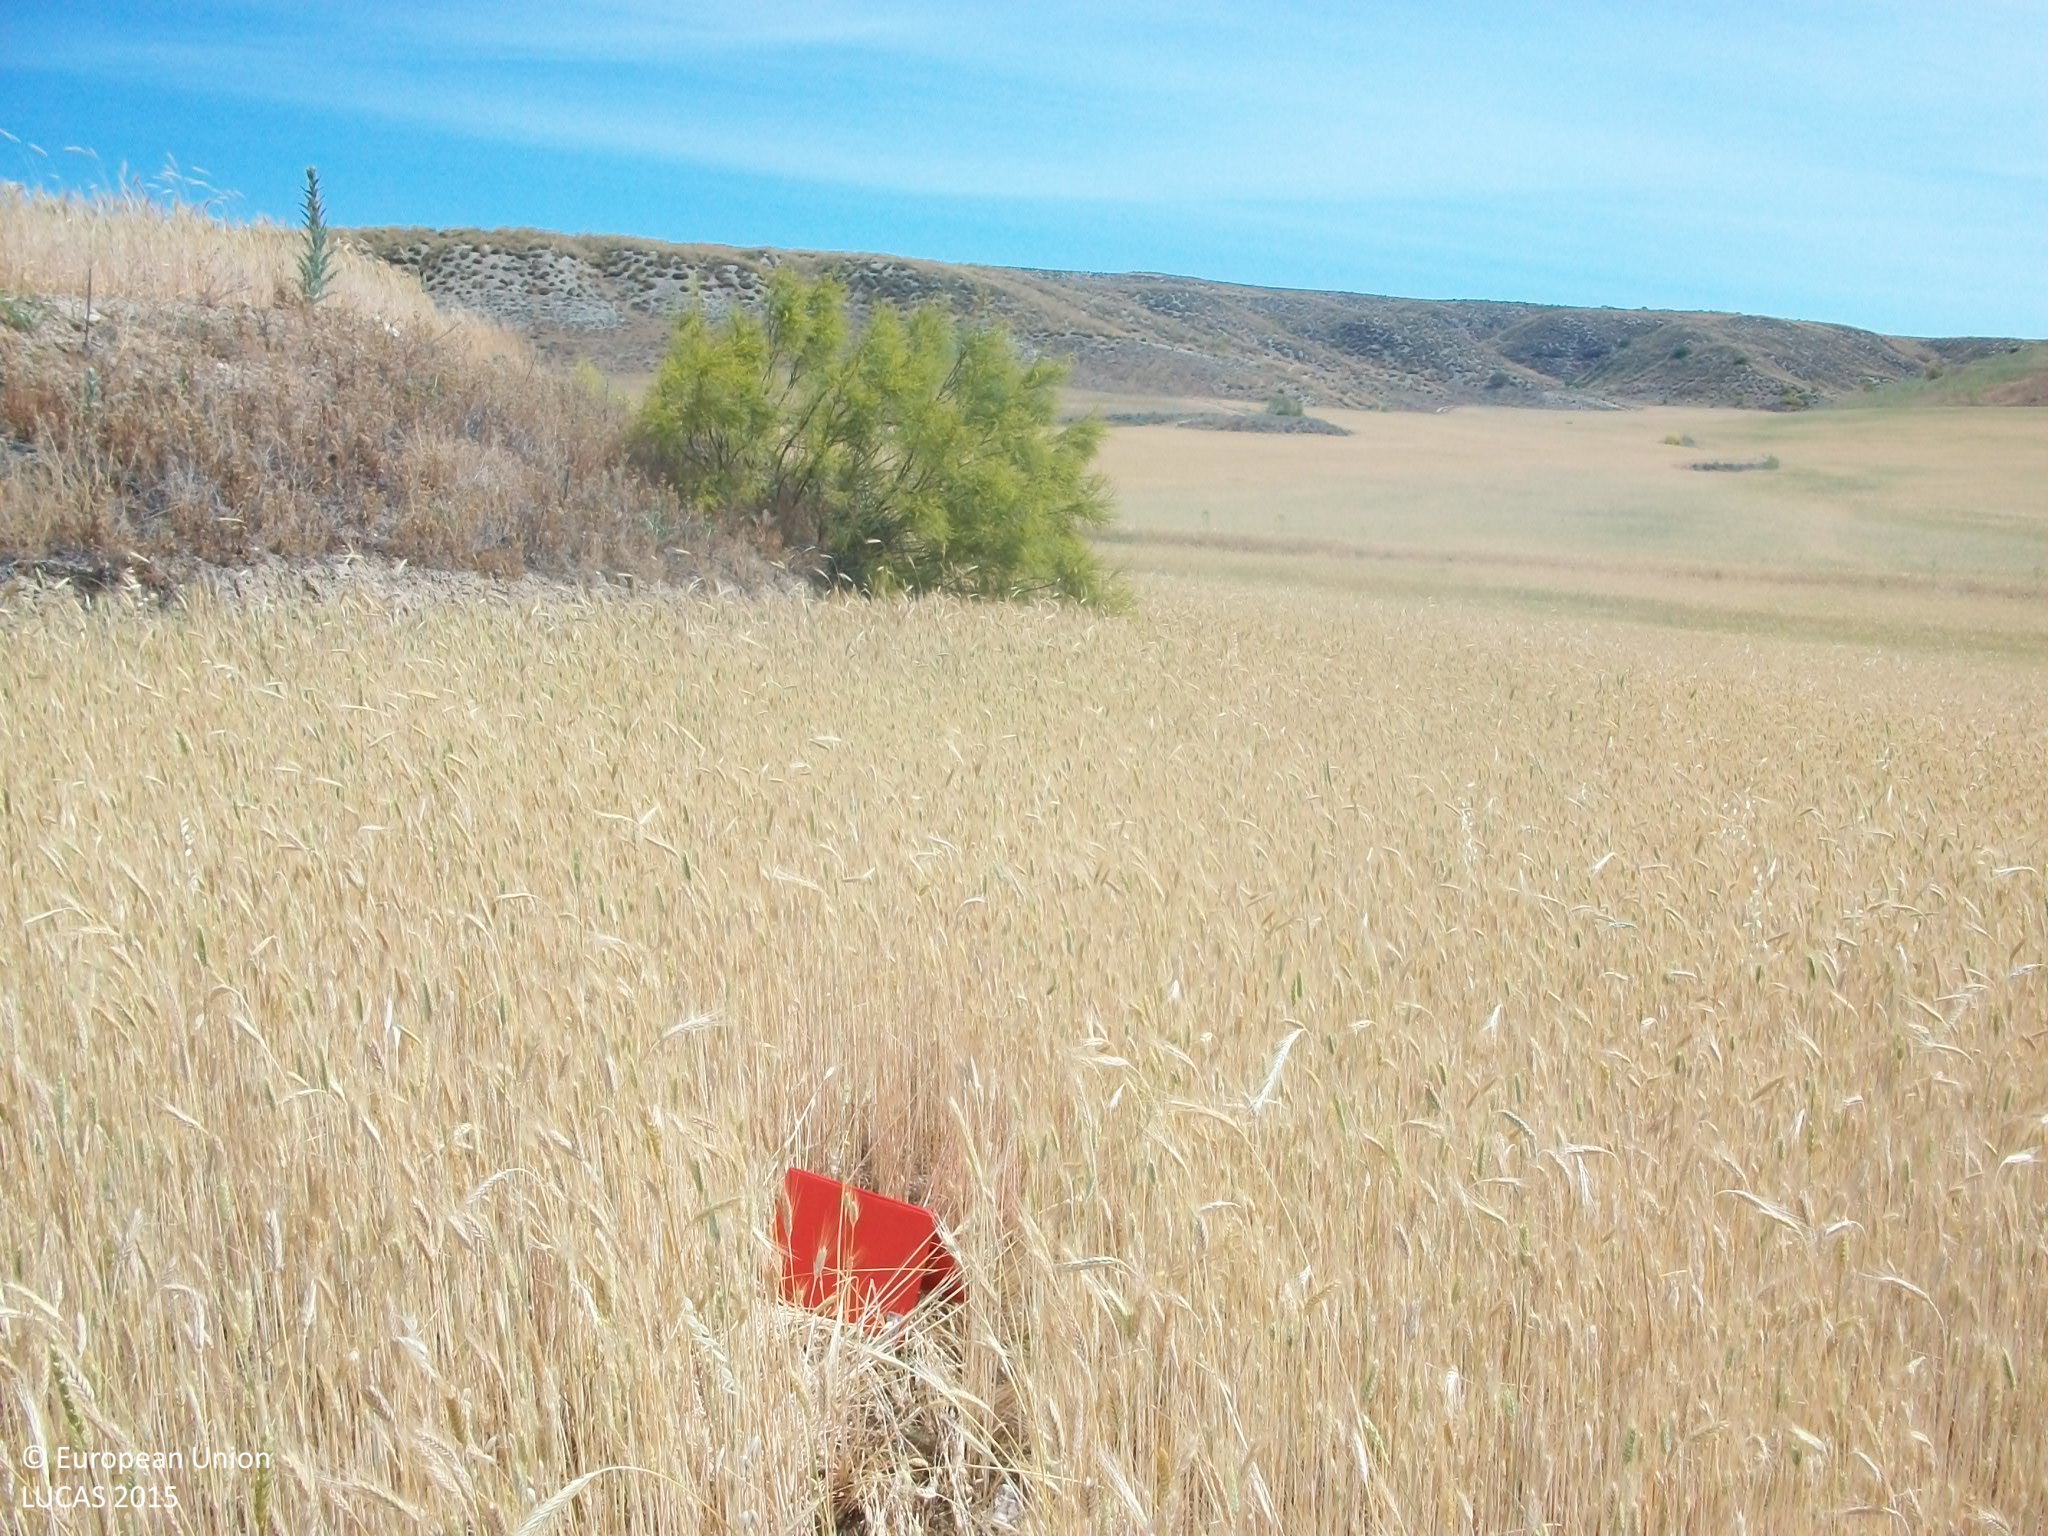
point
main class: Cropland
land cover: Common wheat
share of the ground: > 75 %
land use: Agriculture (excluding fallow land and kitchen gardens)
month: May
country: ES
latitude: 40.0539
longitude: -3.6893
